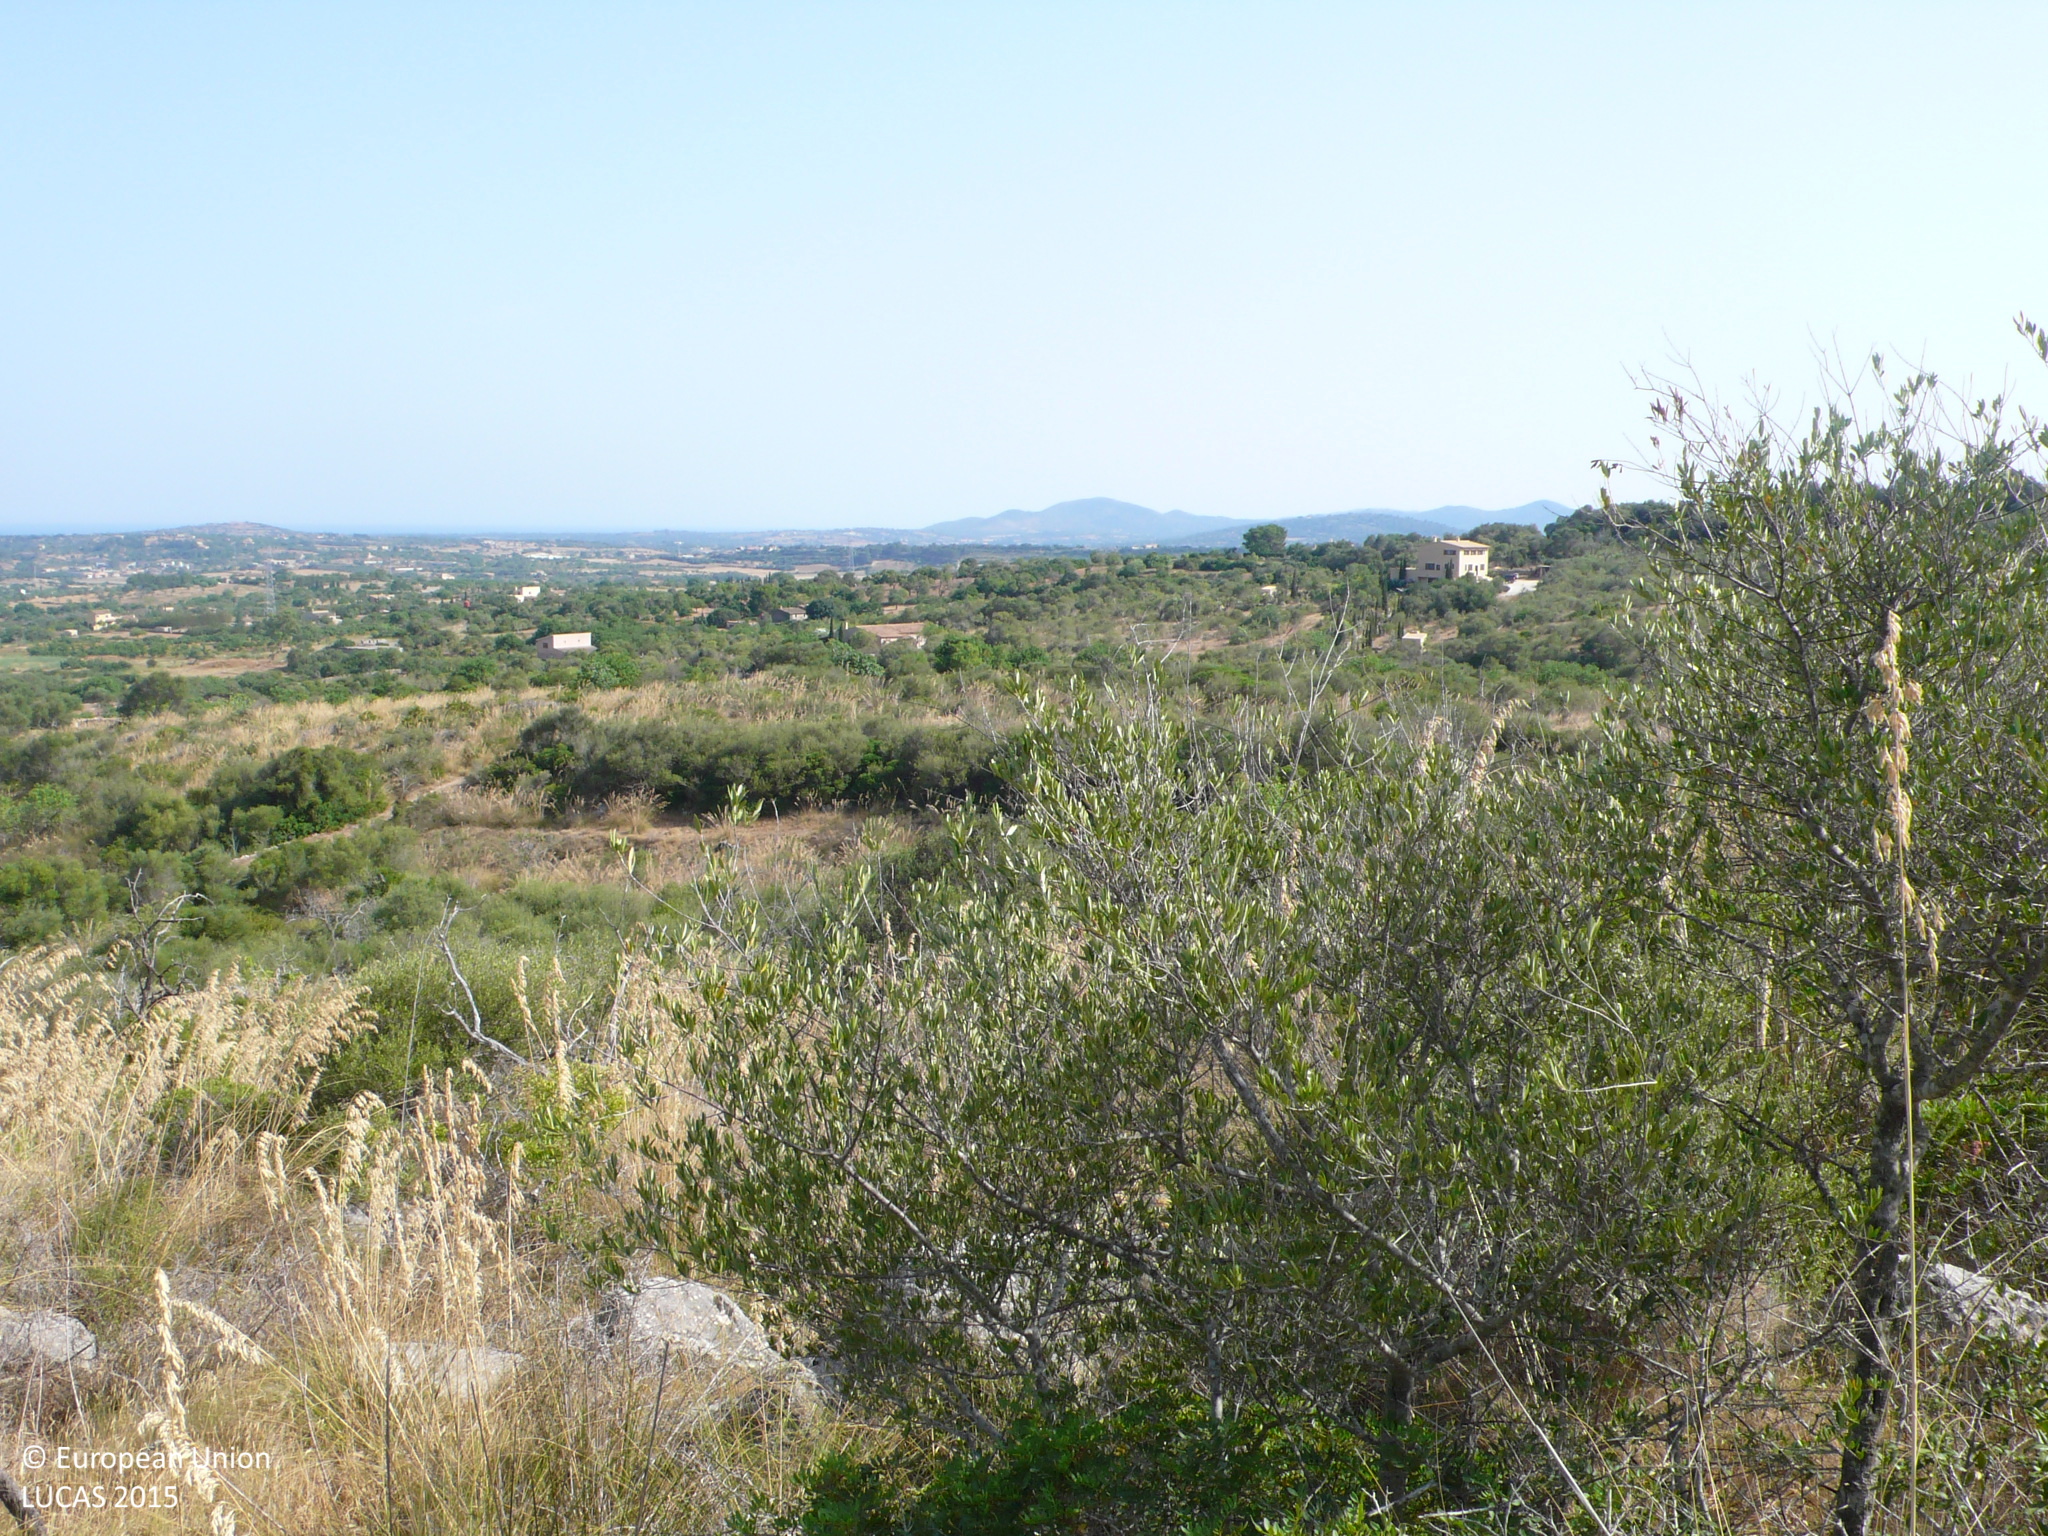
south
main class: Woodland
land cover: Broadleaved woodland
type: broadleaved evergreen forest
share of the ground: 50 - 75 %
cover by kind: broadleaved forest trees 55 %, shrubs 30 %, consolidated bare surface 15 %
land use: Semi-natural and natural areas not in use
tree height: < 5 m
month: July
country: ES
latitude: 39.6358
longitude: 3.2599
